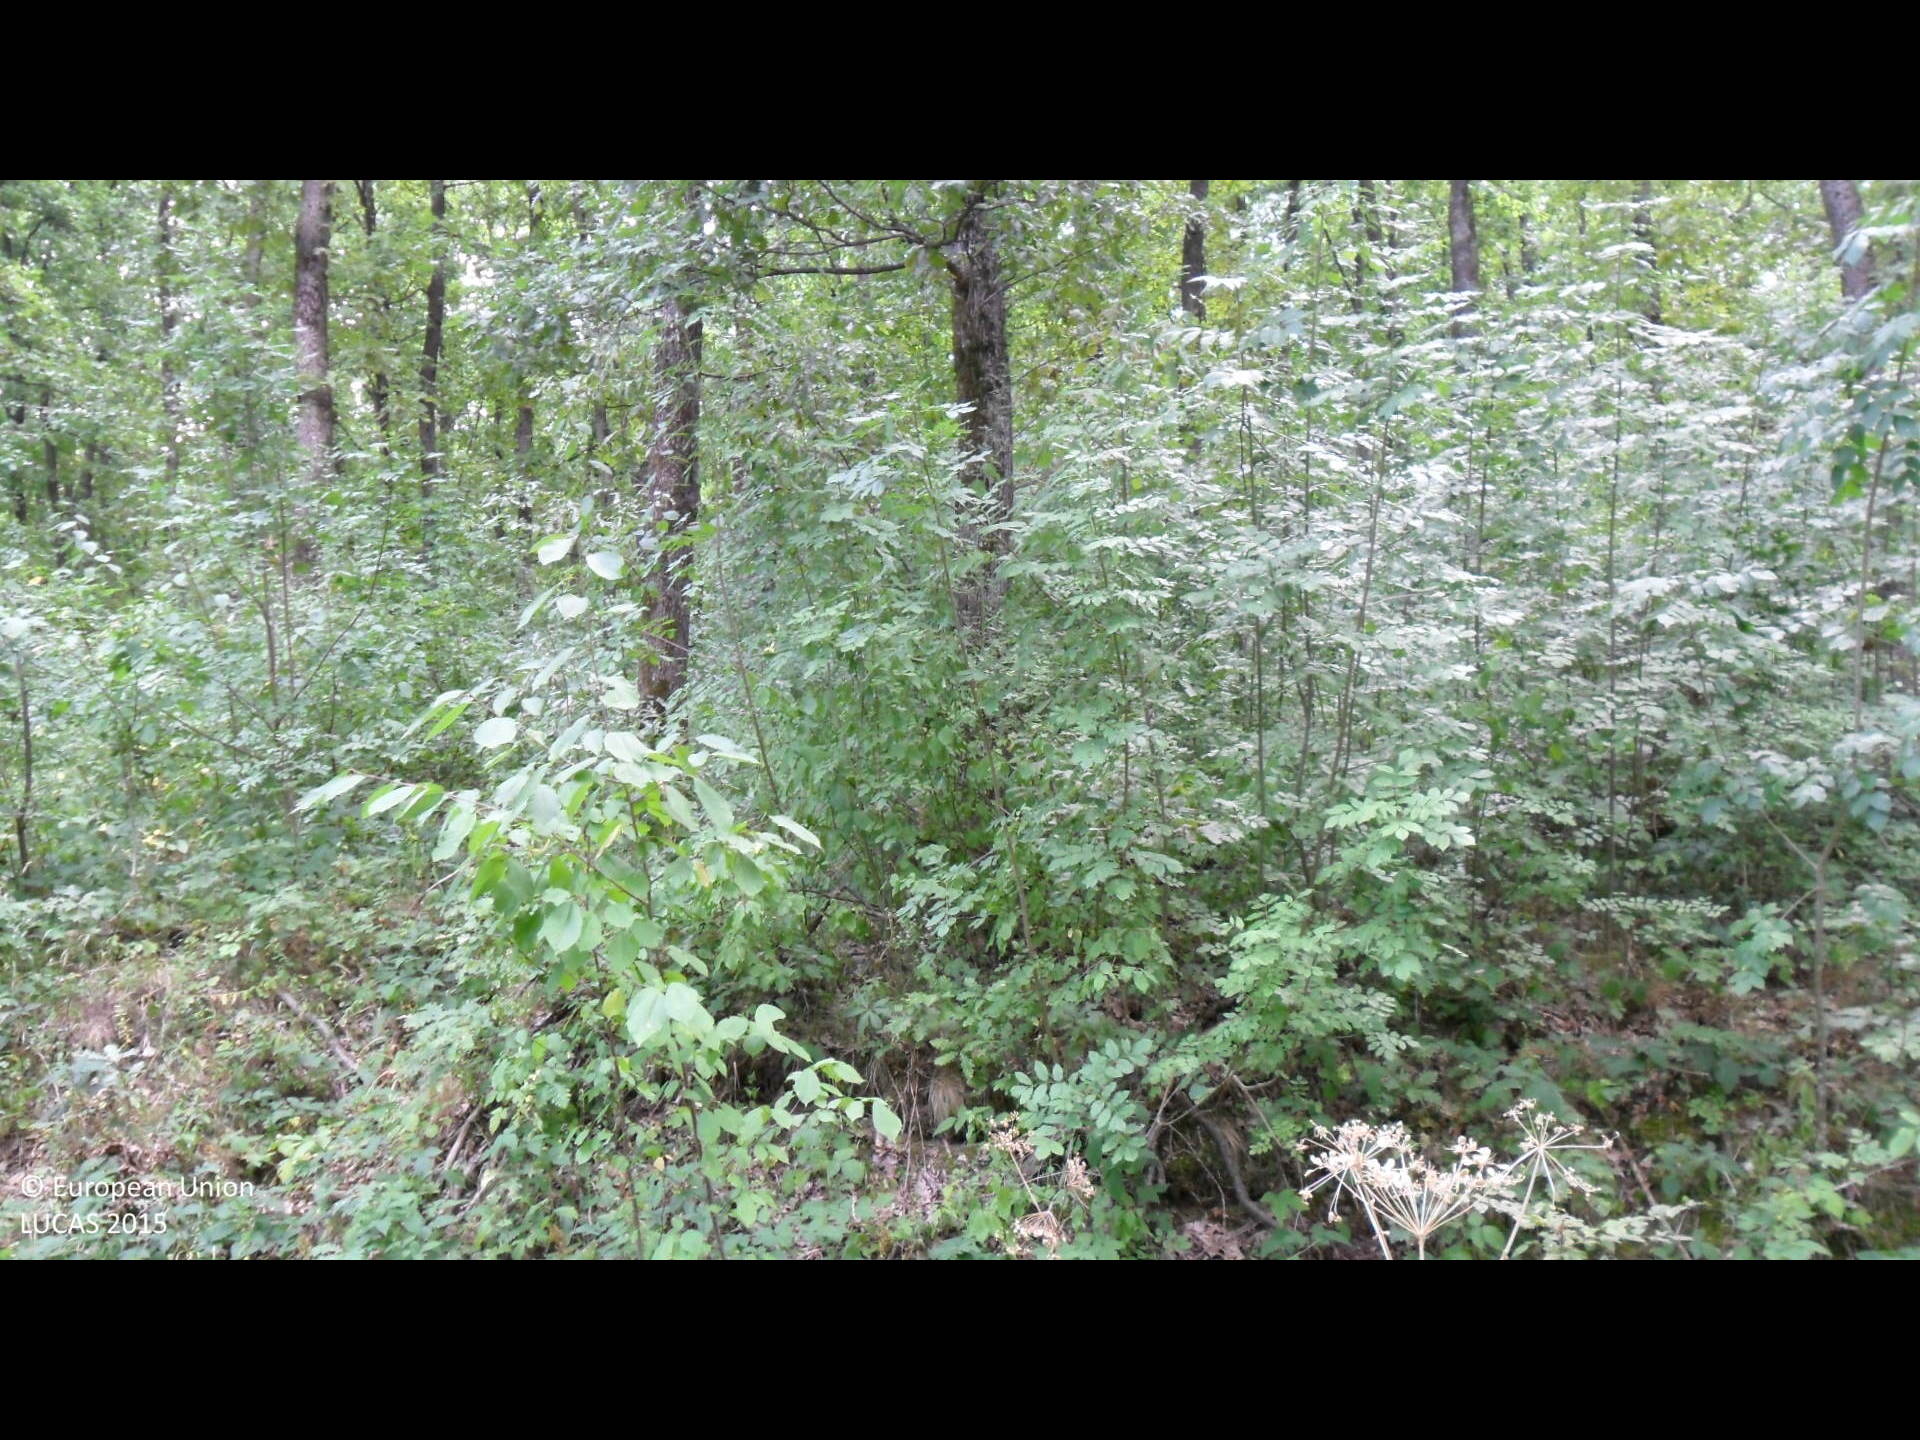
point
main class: Woodland
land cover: Broadleaved woodland
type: mesophytic deciduous forest
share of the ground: > 75 %
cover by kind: broadleaved forest trees 95 %, shrubs 5 %
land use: Forestry
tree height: > 5 m
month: August
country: BG
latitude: 43.2776
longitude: 26.3768
